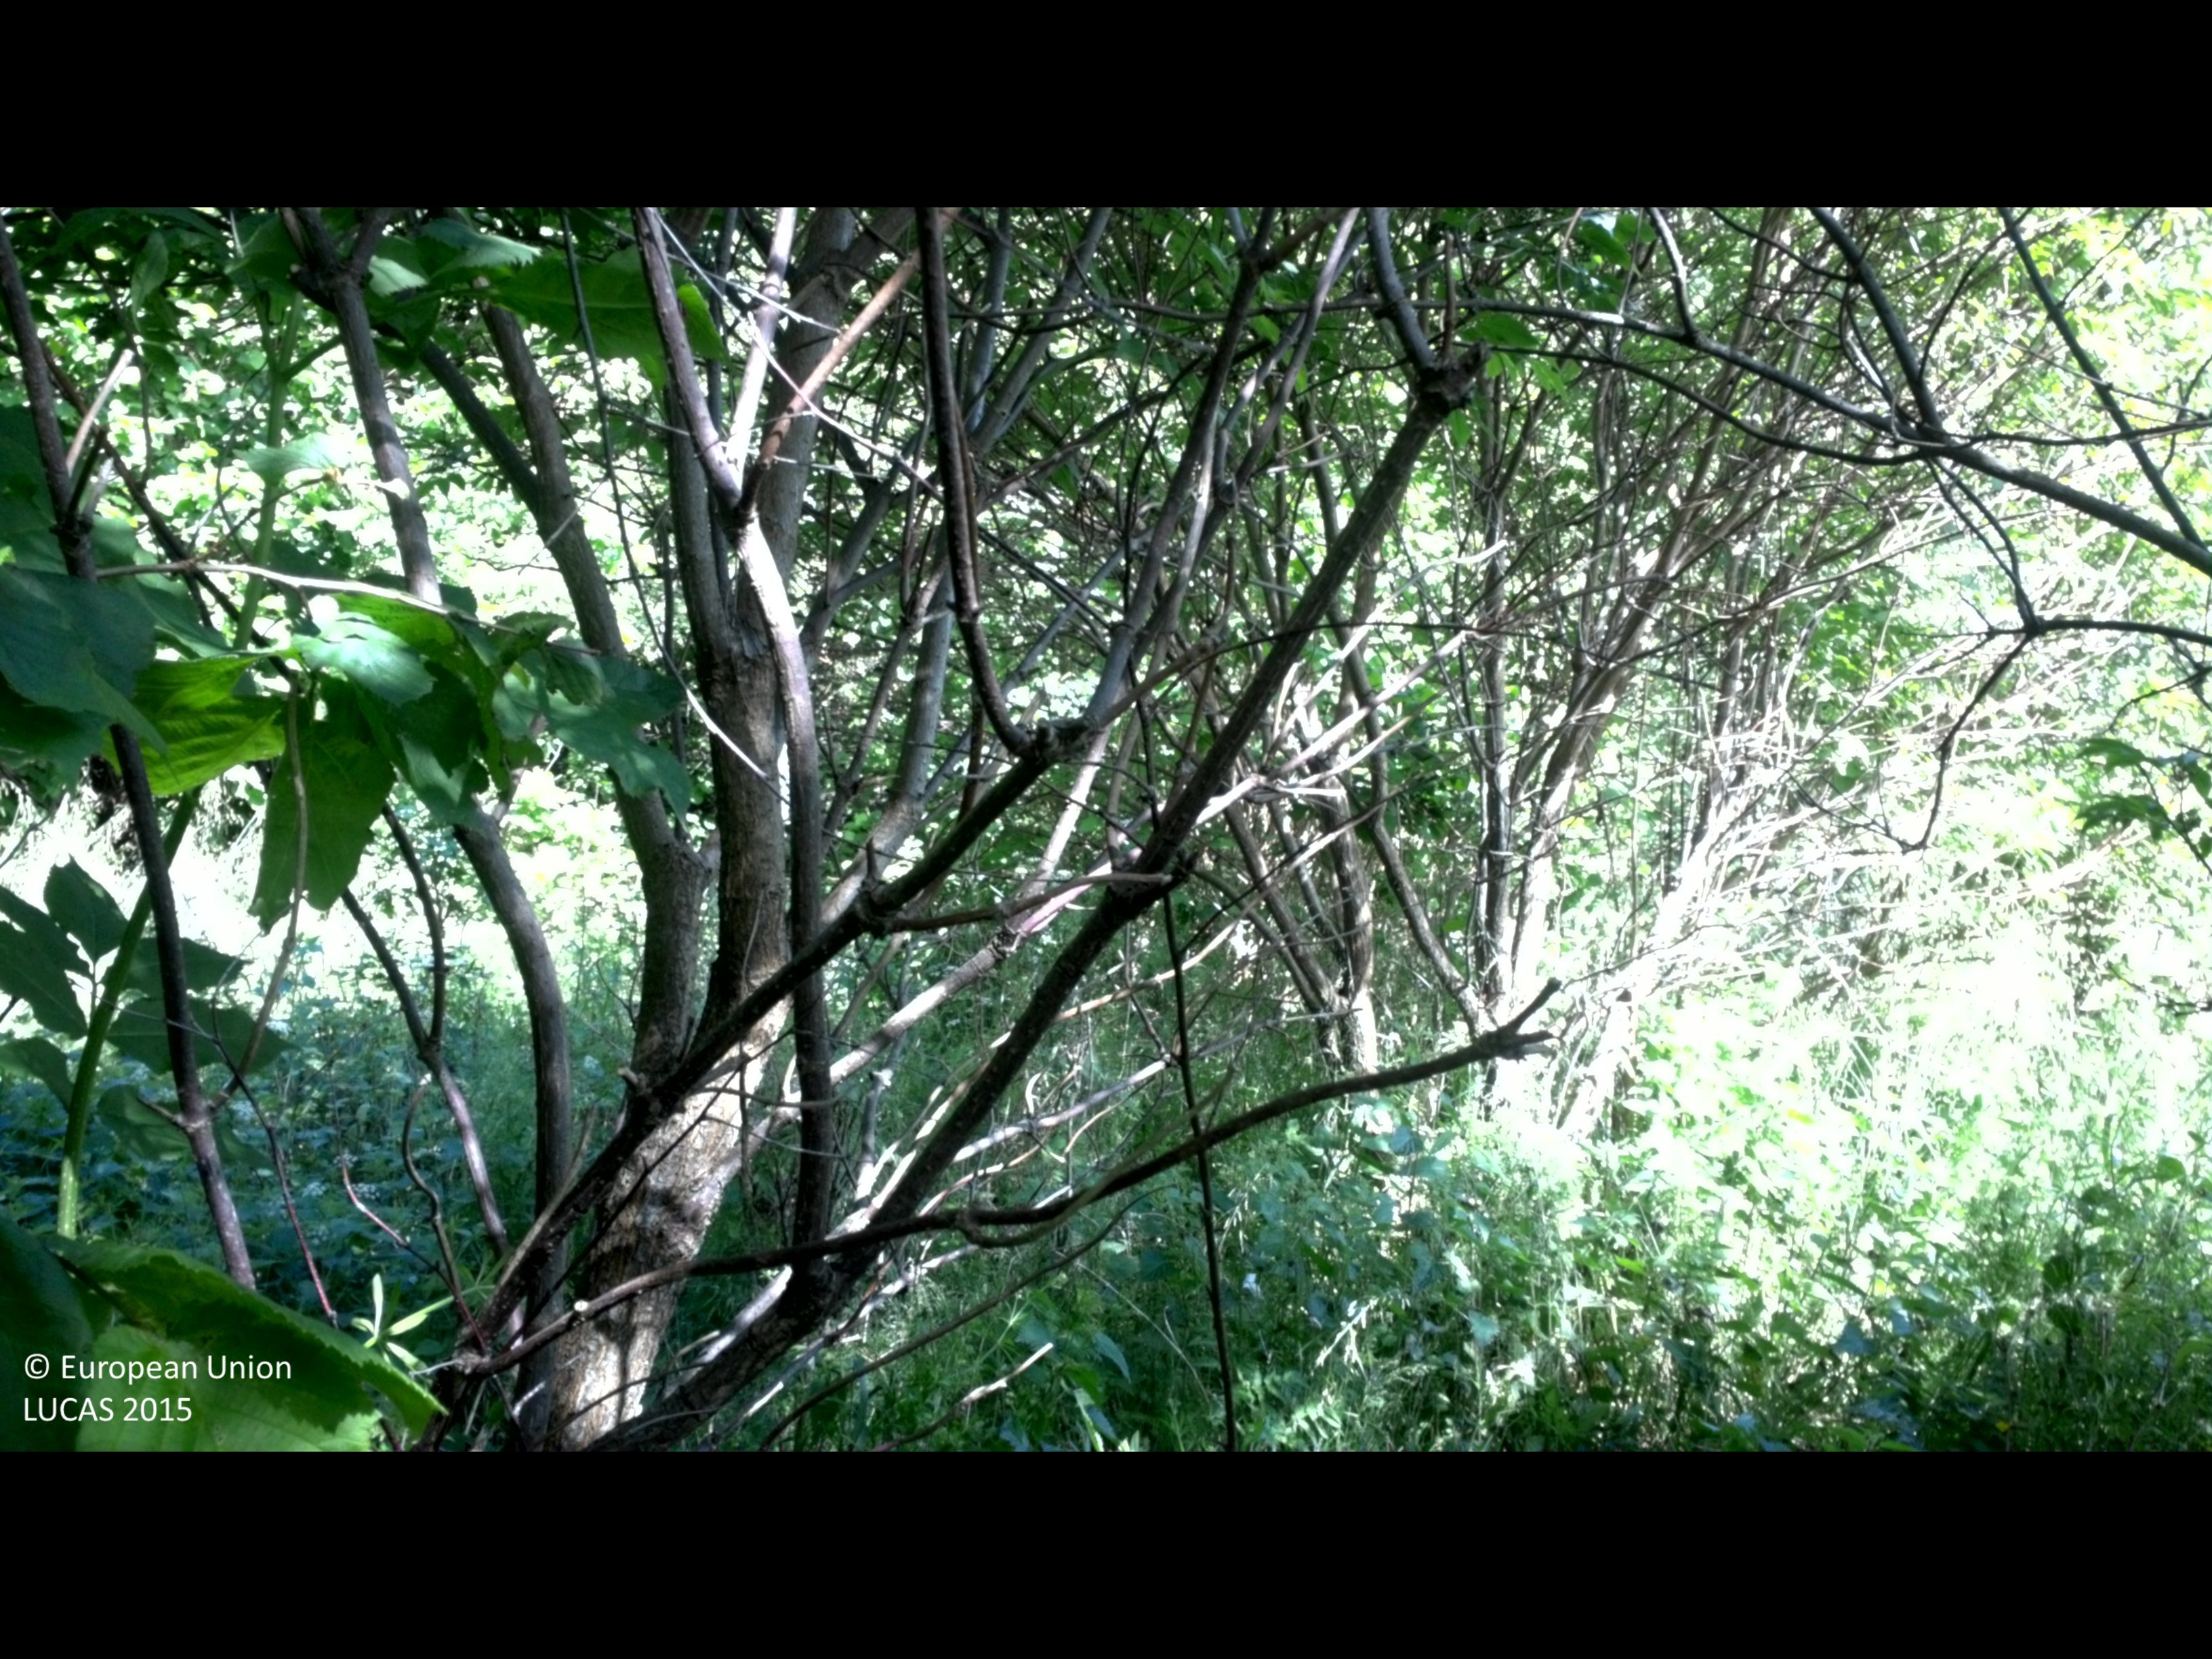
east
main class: Woodland
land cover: Broadleaved woodland
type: hemiboreal forest and nemoral coniferous forest and mixed broadleaved-coniferous forest
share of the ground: 25 - 50 %
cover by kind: shrubs 45 %, broadleaved forest trees 40 %, herbaceous plants 15 %
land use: Forestry
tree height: > 5 m
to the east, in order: Broadleaved woodland; Other mixed woodland; Broadleaved woodland; Spruce dominated coniferous woodland; Tracks; Spruce dominated coniferous woodland; Broadleaved woodland; Grassland without tree/shrub cover
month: June
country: SE
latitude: 57.8918
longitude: 16.6615
